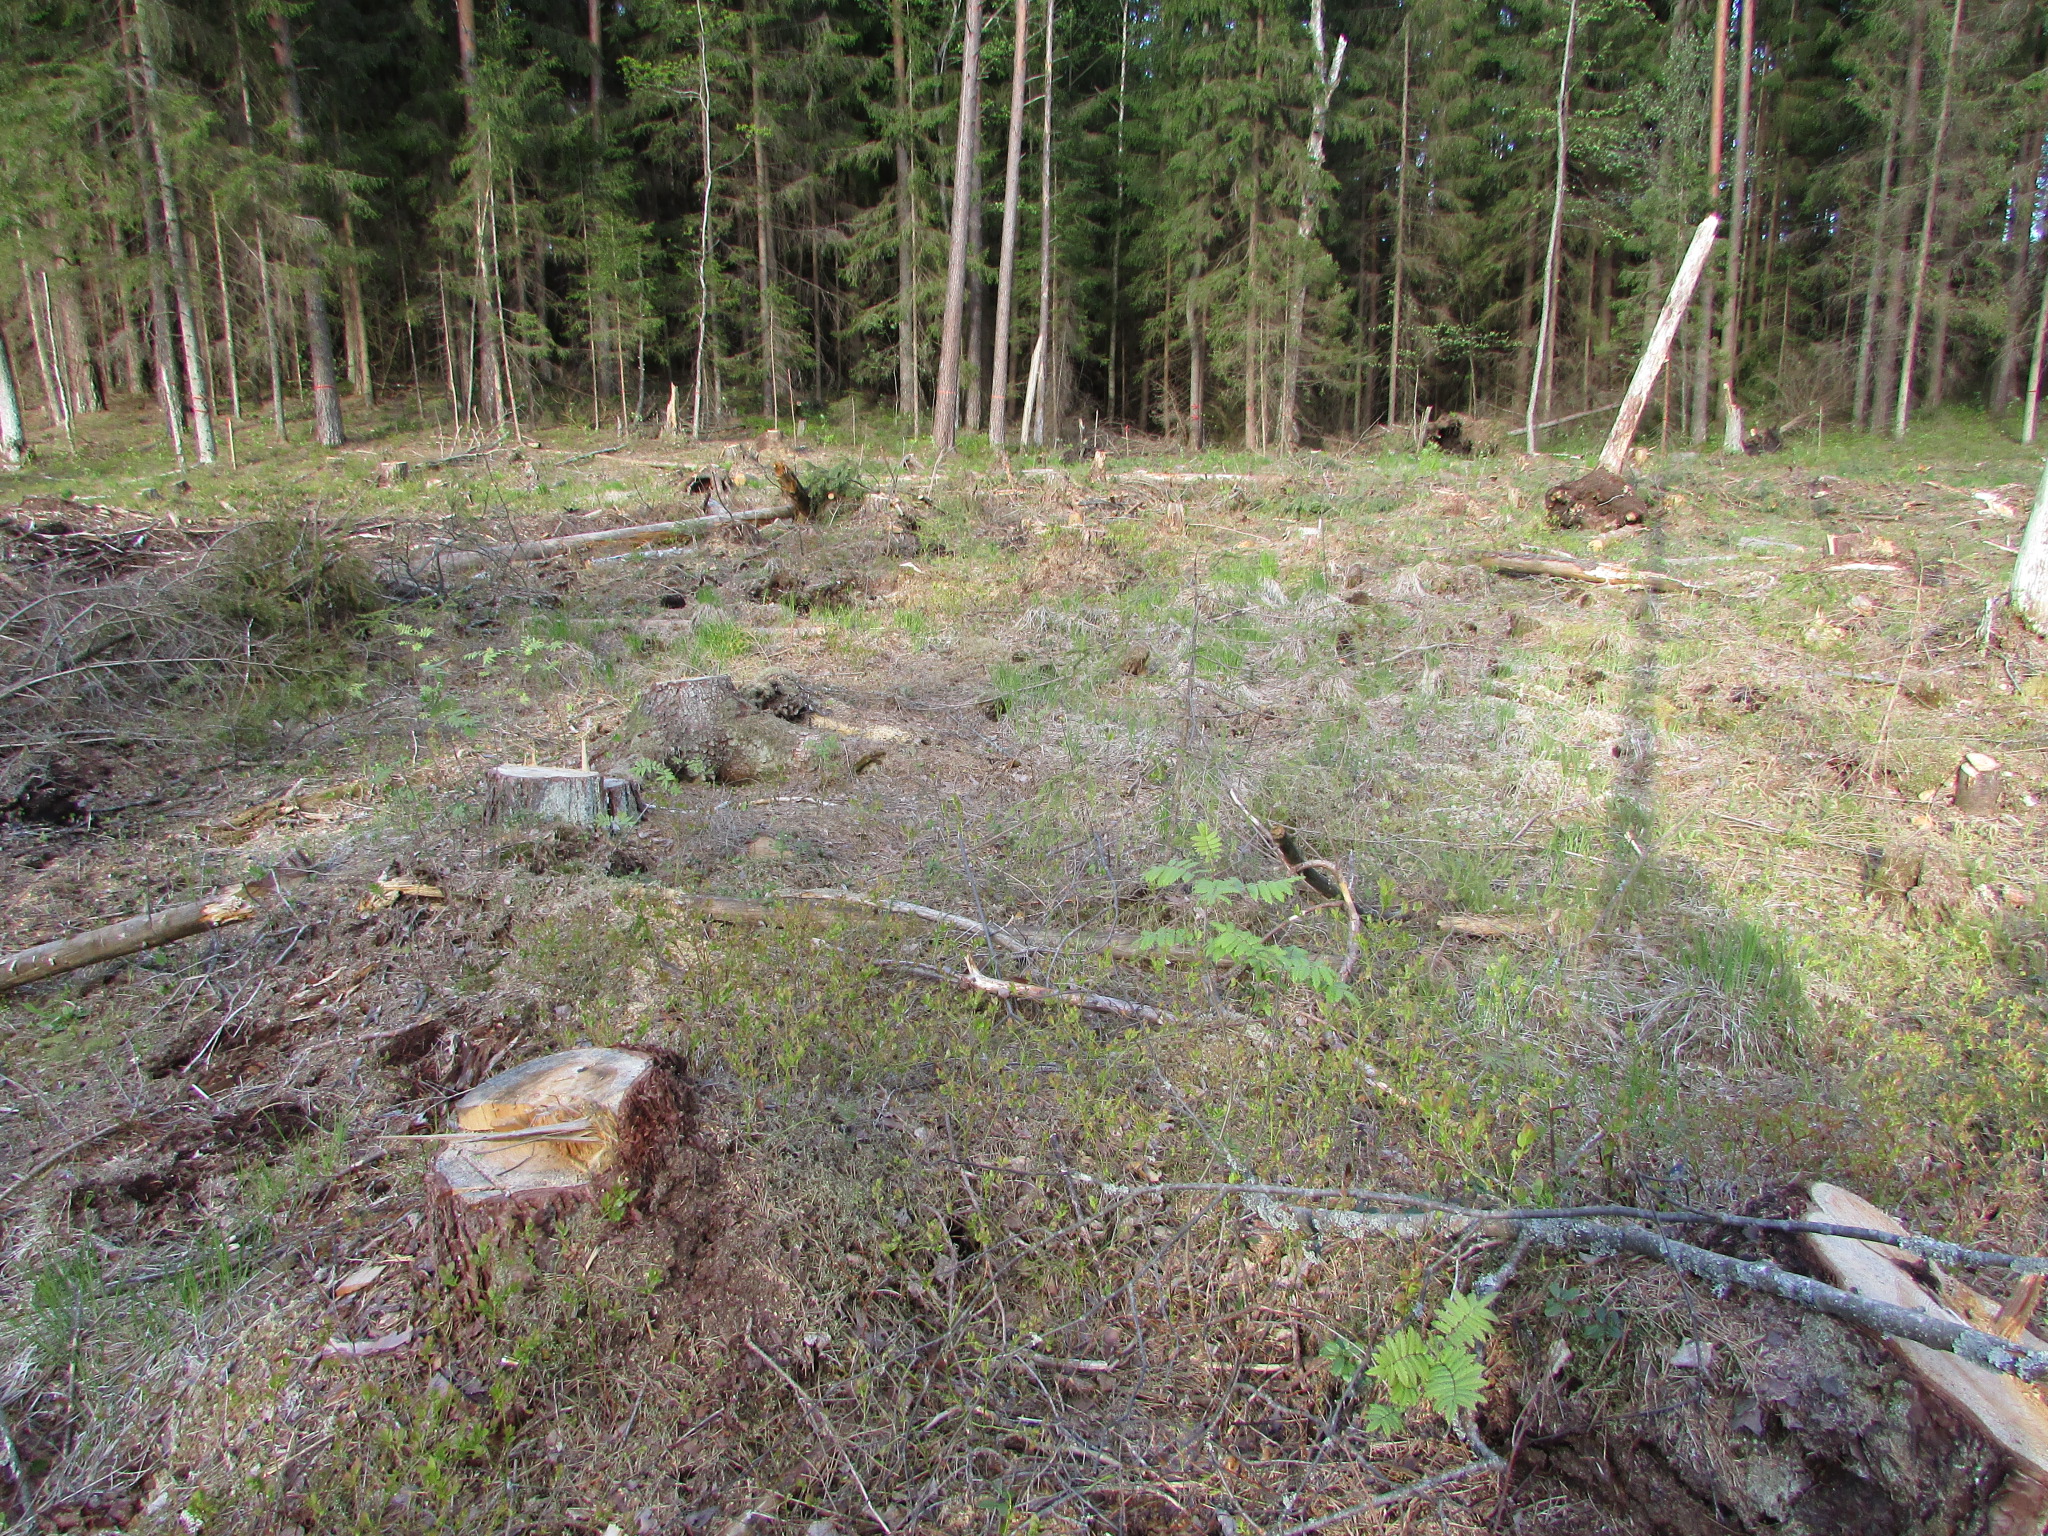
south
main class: Grassland
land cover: Spontaneously vegetated surfaces
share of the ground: 25 - 50 %
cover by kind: unconsolidated bare surface 60 %, herbaceous plants 30 %
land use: Forestry
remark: Clear cut
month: May
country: LV
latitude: 56.1618
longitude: 27.1575
